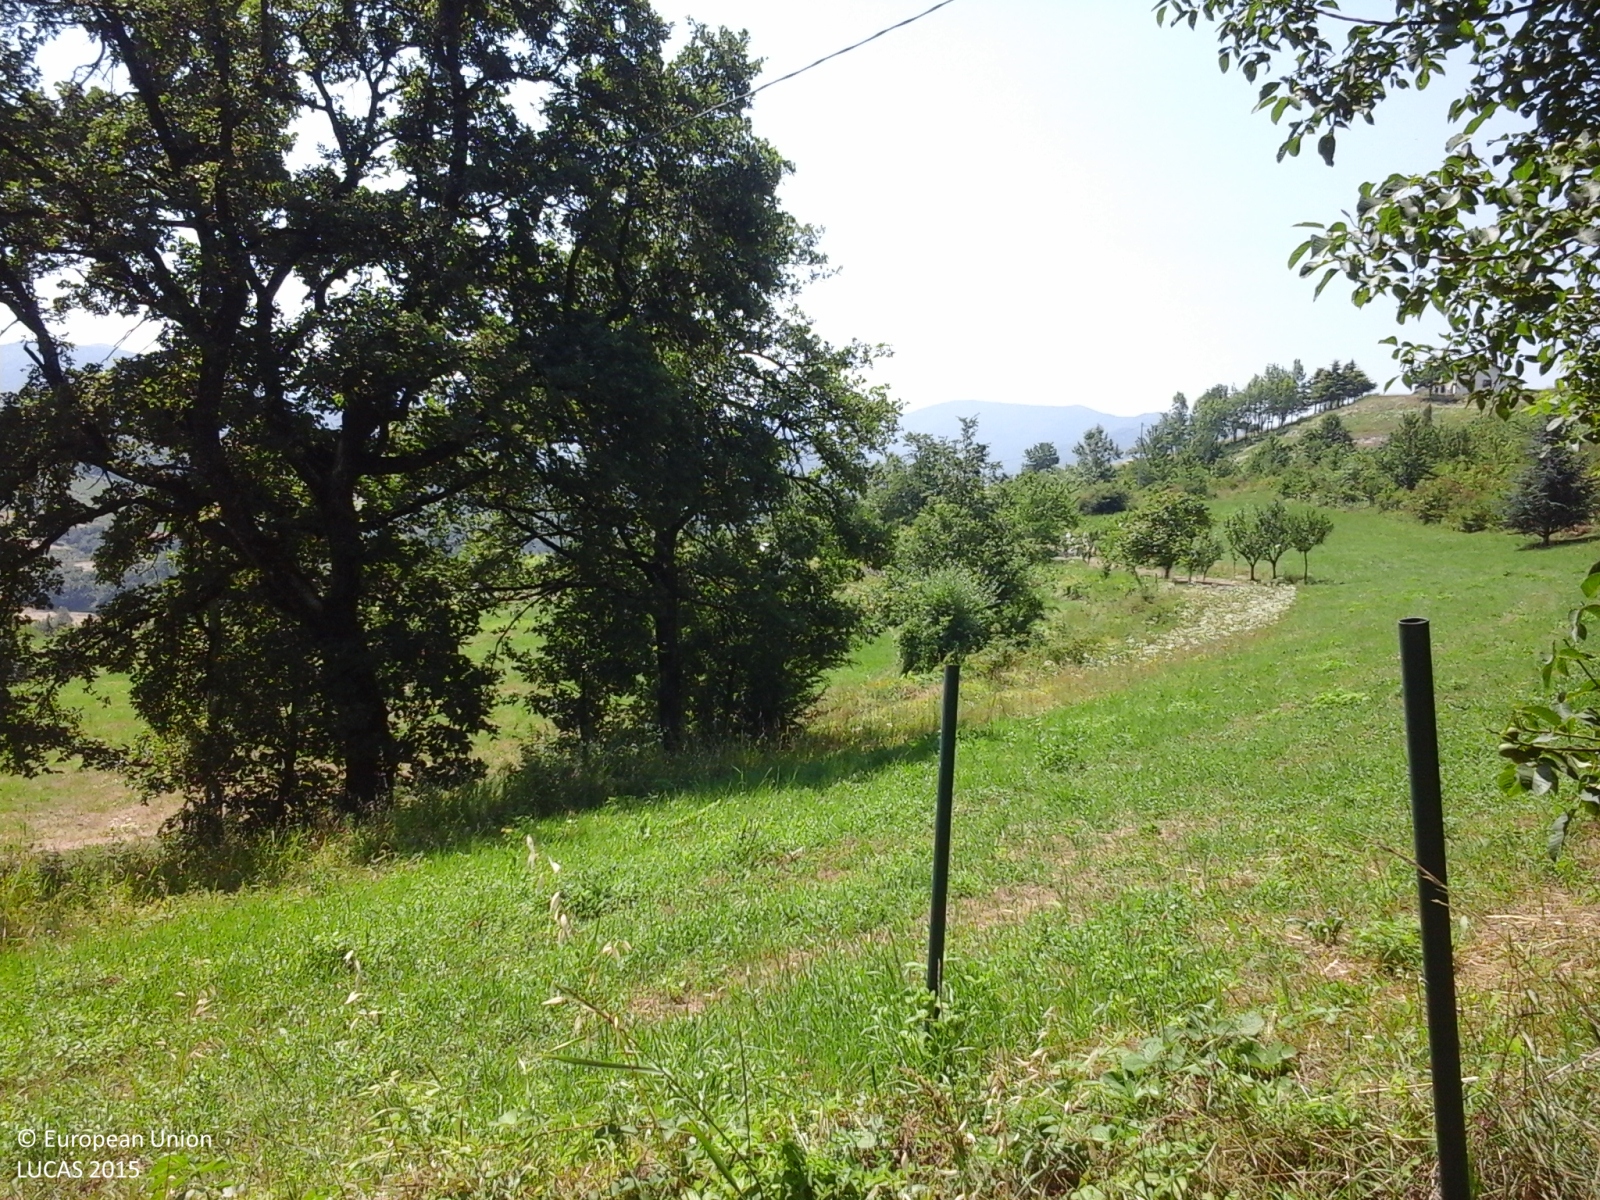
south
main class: Grassland
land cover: Grassland with sparse tree/shrub cover
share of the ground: > 75 %
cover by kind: herbaceous plants 95 %, broadleaved forest trees 5 %
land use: Agriculture (excluding fallow land and kitchen gardens)
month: June
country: IT
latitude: 44.6683
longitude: 8.8042
